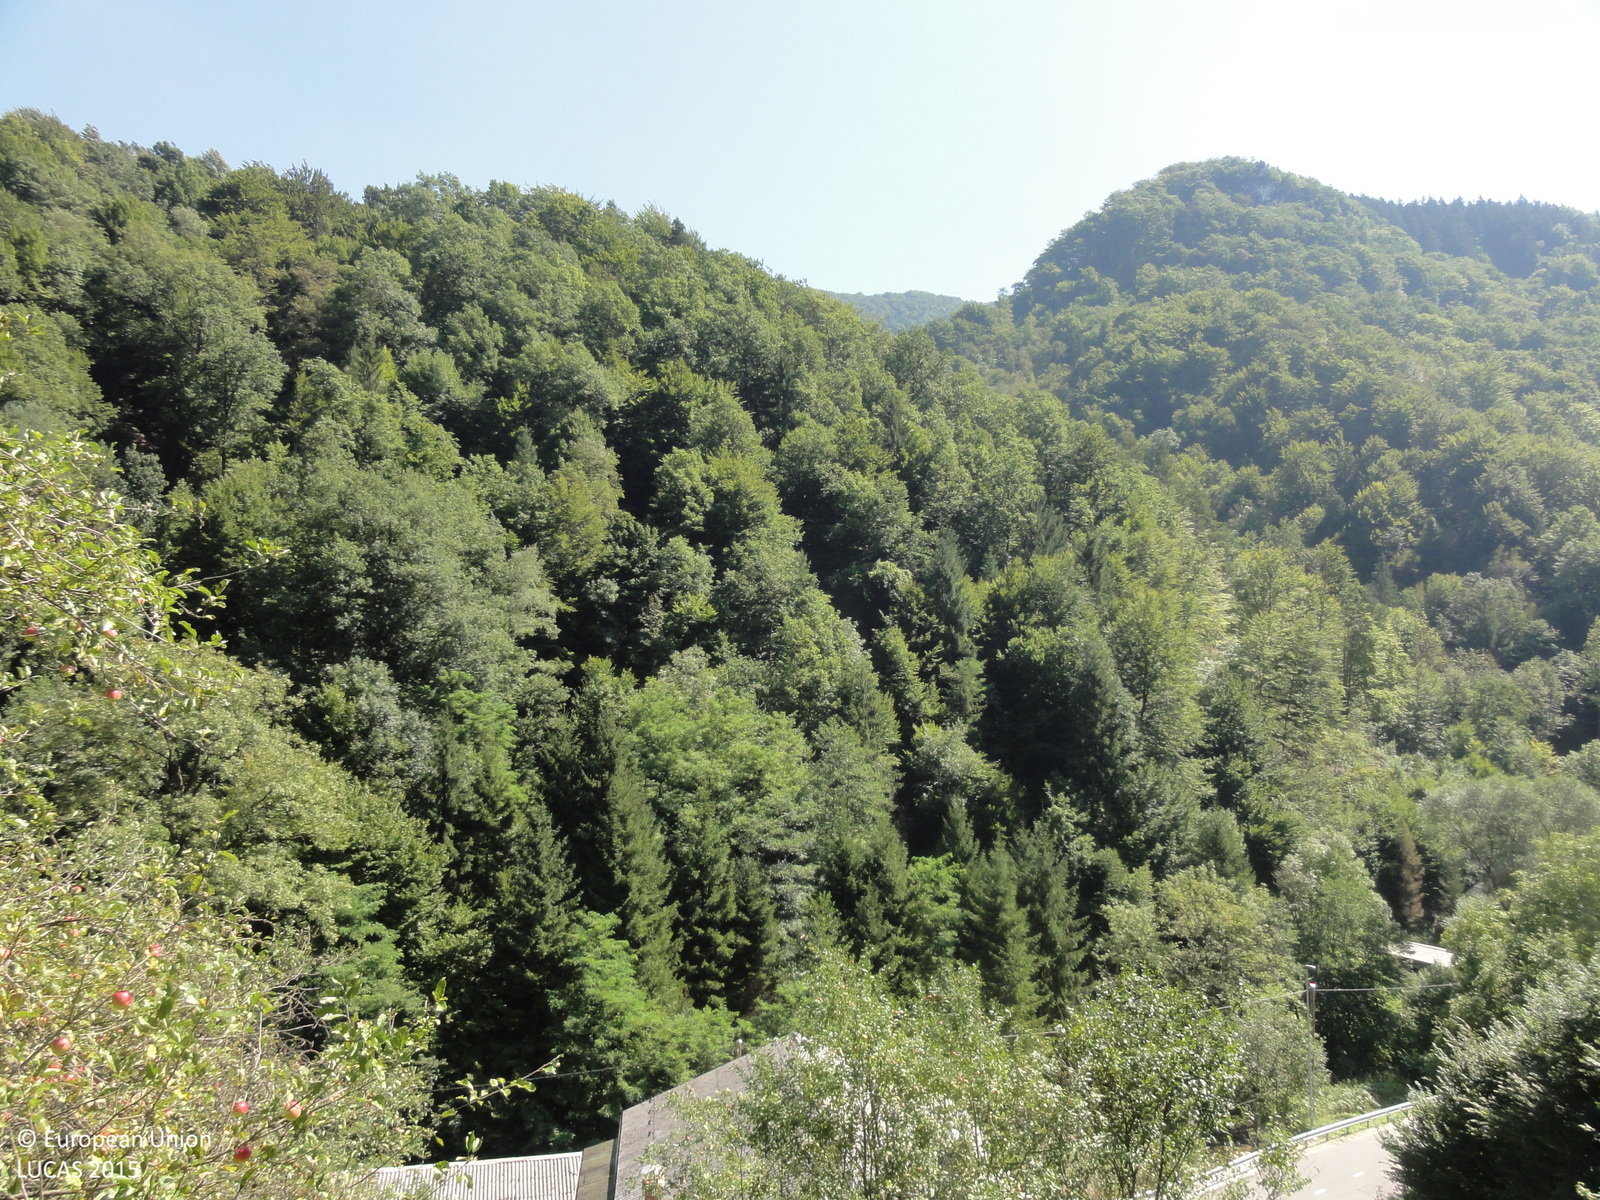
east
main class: Cropland
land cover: Apple fruit
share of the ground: 50 - 75 %
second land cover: Grassland without tree/shrub cover
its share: > 75 %
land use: Kitchen garden
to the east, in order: Apple fruit; Grassland without tree/shrub cover; Artificial constructions in urban areas; Rivers and streams; Spruce dominated mixed woodland; Tracks; Spruce dominated mixed woodland; Electric lines; Spruce dominated mixed woodland
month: August
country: SI
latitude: 46.1581
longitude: 15.0864
